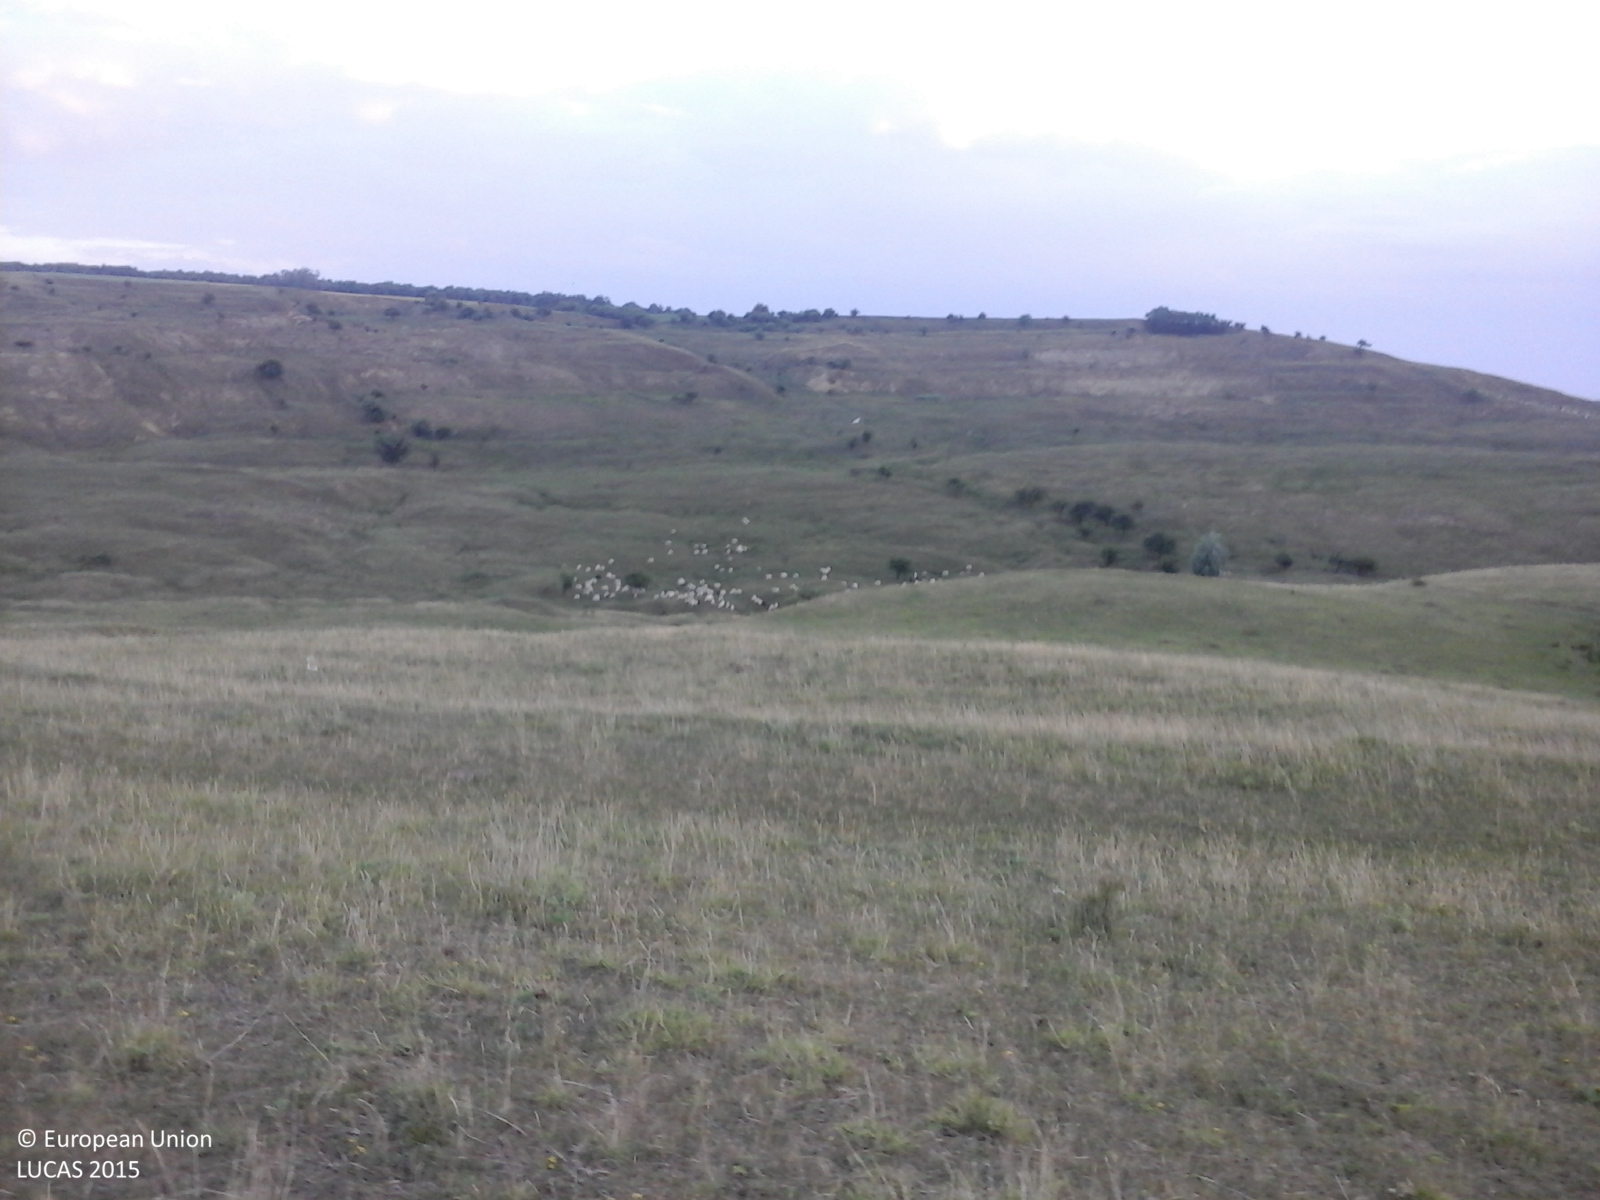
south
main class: Grassland
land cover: Grassland without tree/shrub cover
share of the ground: > 75 %
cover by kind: herbaceous plants 100 %
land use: Agriculture (excluding fallow land and kitchen gardens)
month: June
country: RO
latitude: 46.8270
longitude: 27.0497
